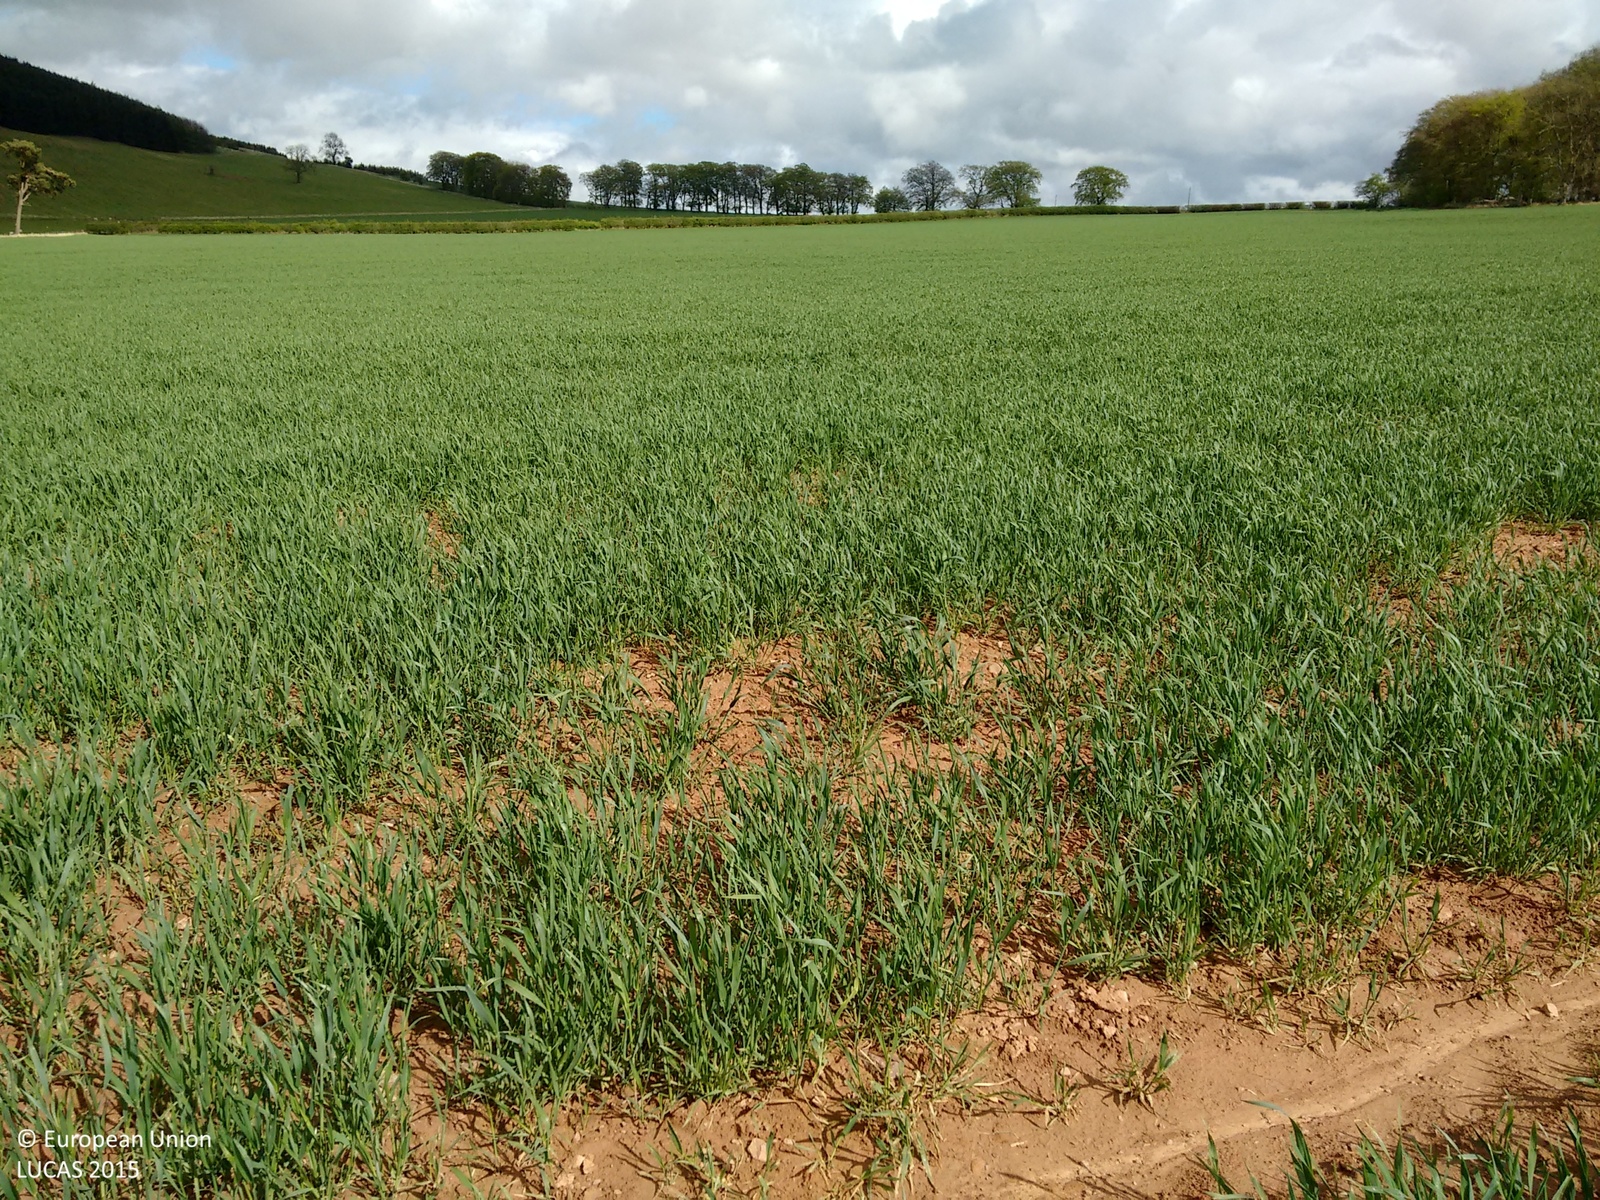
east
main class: Cropland
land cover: Oats
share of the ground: 25 - 50 %
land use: Agriculture (excluding fallow land and kitchen gardens)
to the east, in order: Oats
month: May
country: GB
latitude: 55.6129
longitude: -2.6530
